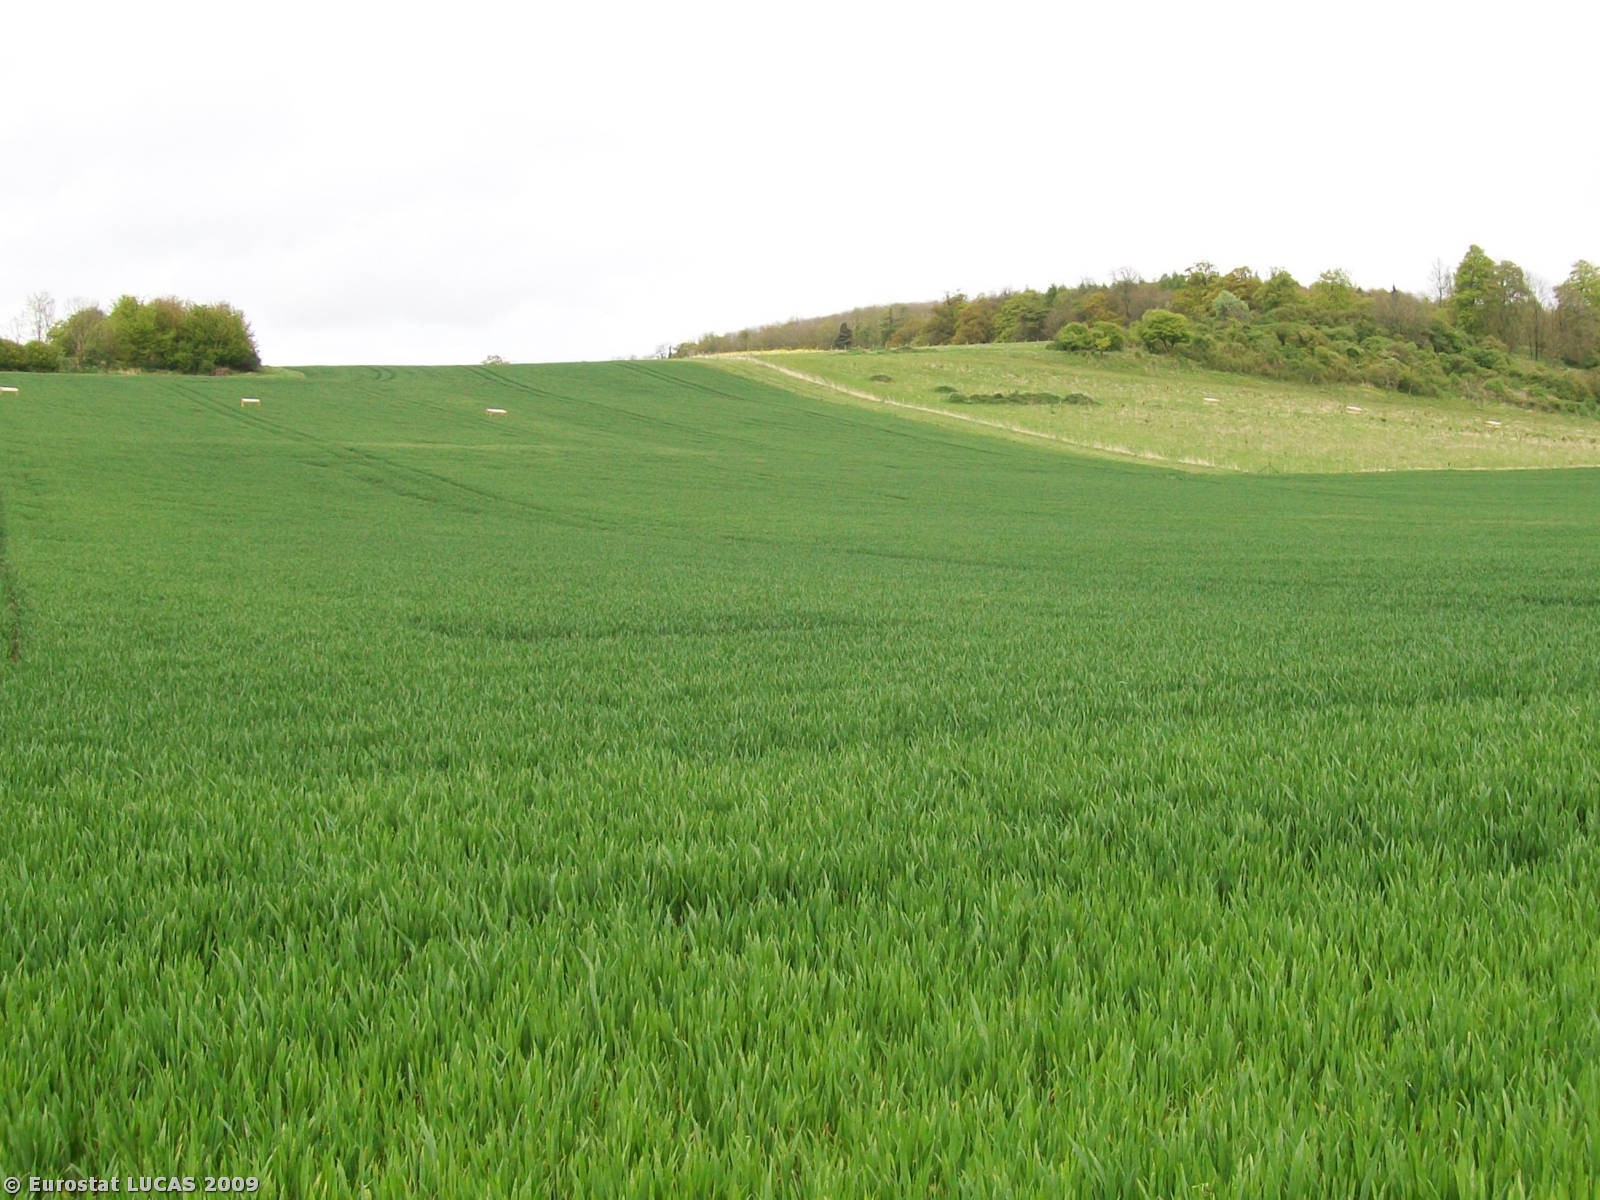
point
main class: Cropland
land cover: Common wheat
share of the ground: > 75 %
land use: Agriculture (excluding fallow land and kitchen gardens)
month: April
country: GB
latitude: 51.5487
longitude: -1.0775
